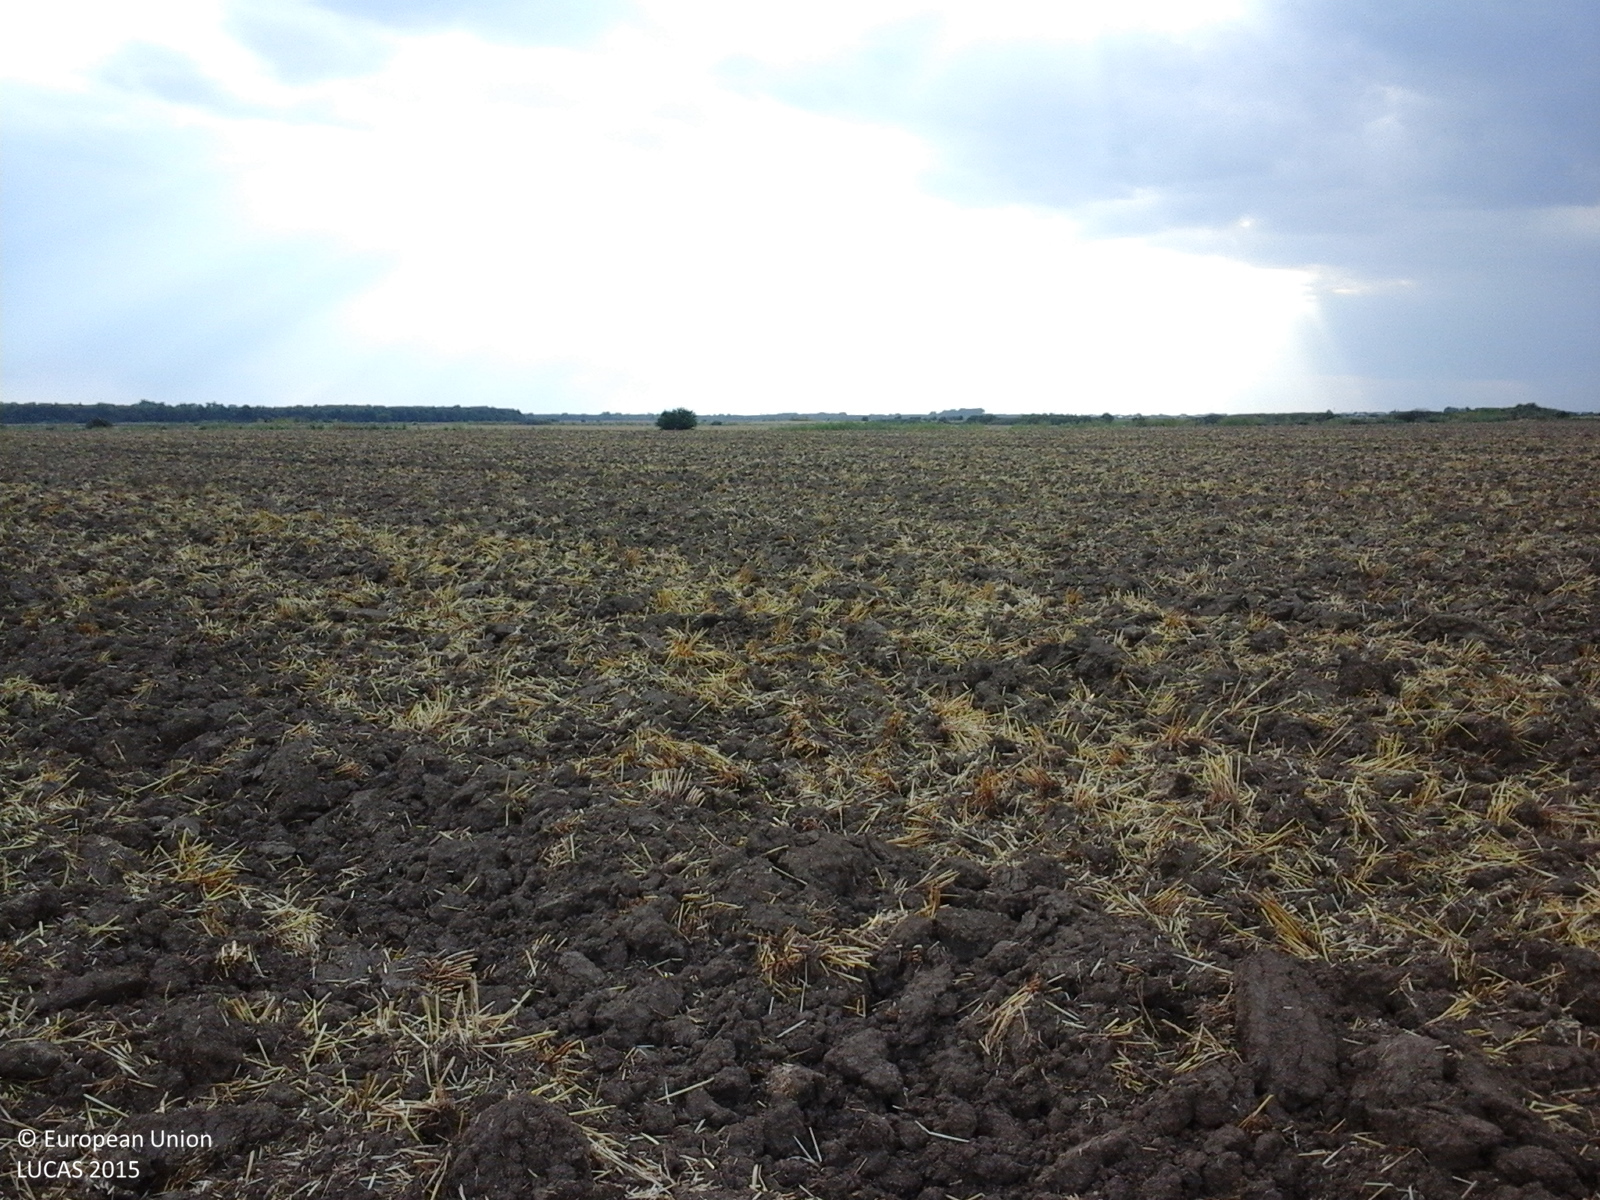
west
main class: Cropland
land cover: Common wheat
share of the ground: 25 - 50 %
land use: Agriculture (excluding fallow land and kitchen gardens)
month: June
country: RO
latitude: 44.2512
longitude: 26.1473
